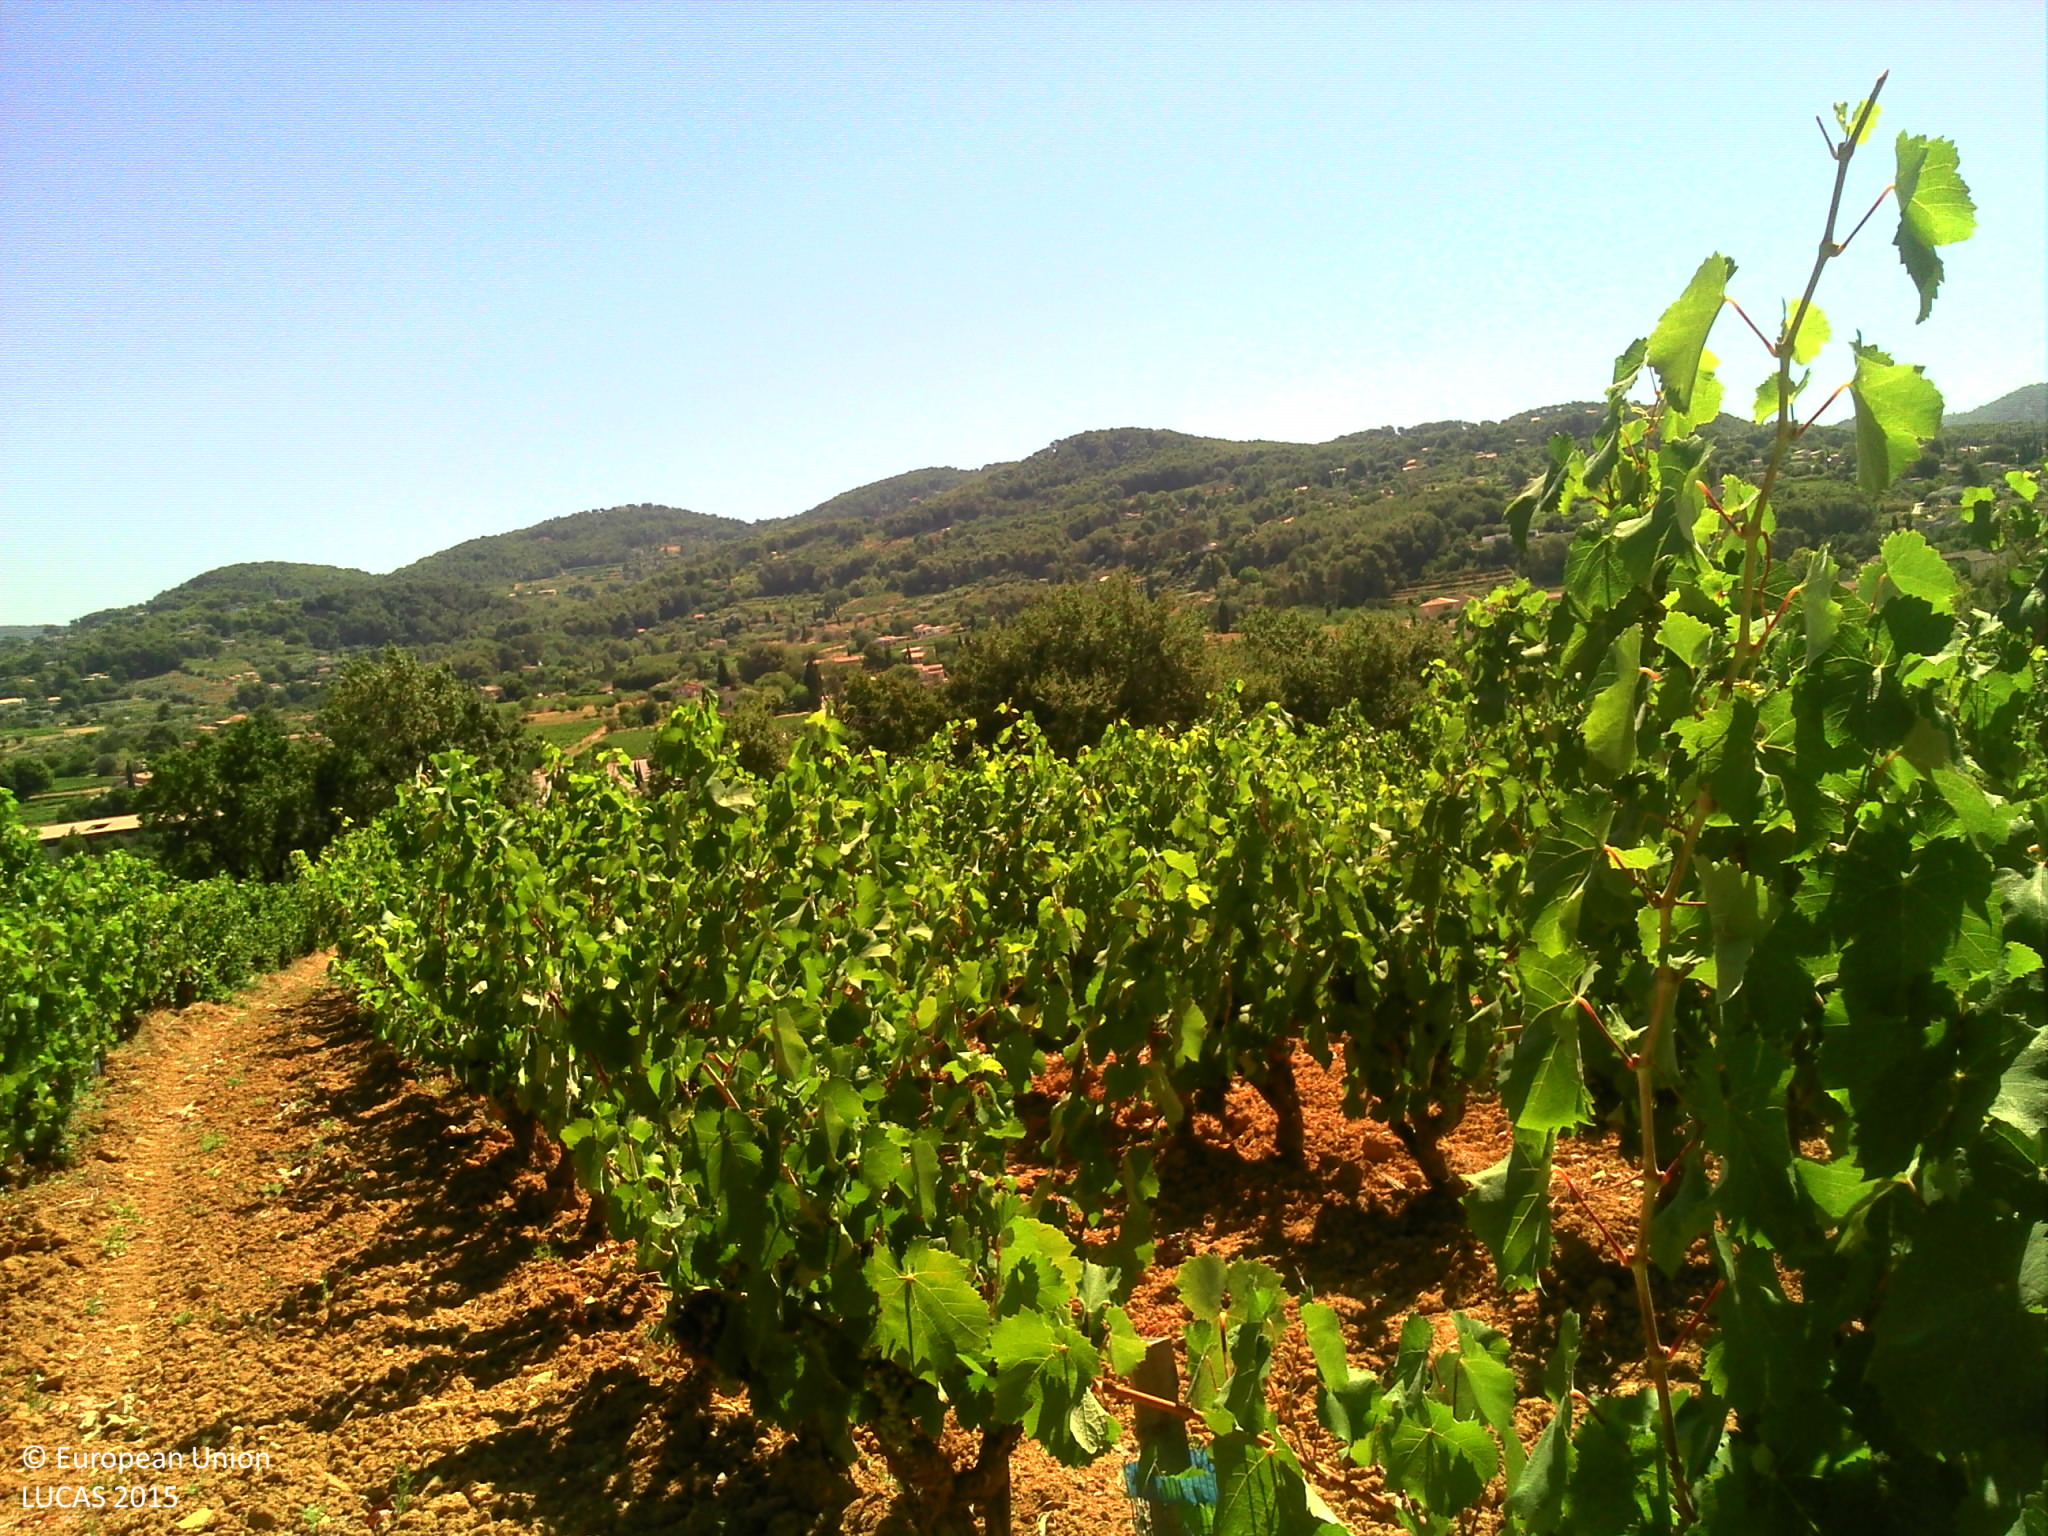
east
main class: Cropland
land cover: Vineyards
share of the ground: 10 - 25 %
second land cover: Other bare soil
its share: > 75 %
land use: Agriculture (excluding fallow land and kitchen gardens)
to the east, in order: Vineyards; Other bare soil; Vineyards; Tracks; Electric lines; Broadleaved woodland; Fences; Vineyards
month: July
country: FR
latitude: 43.1802
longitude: 5.7659
